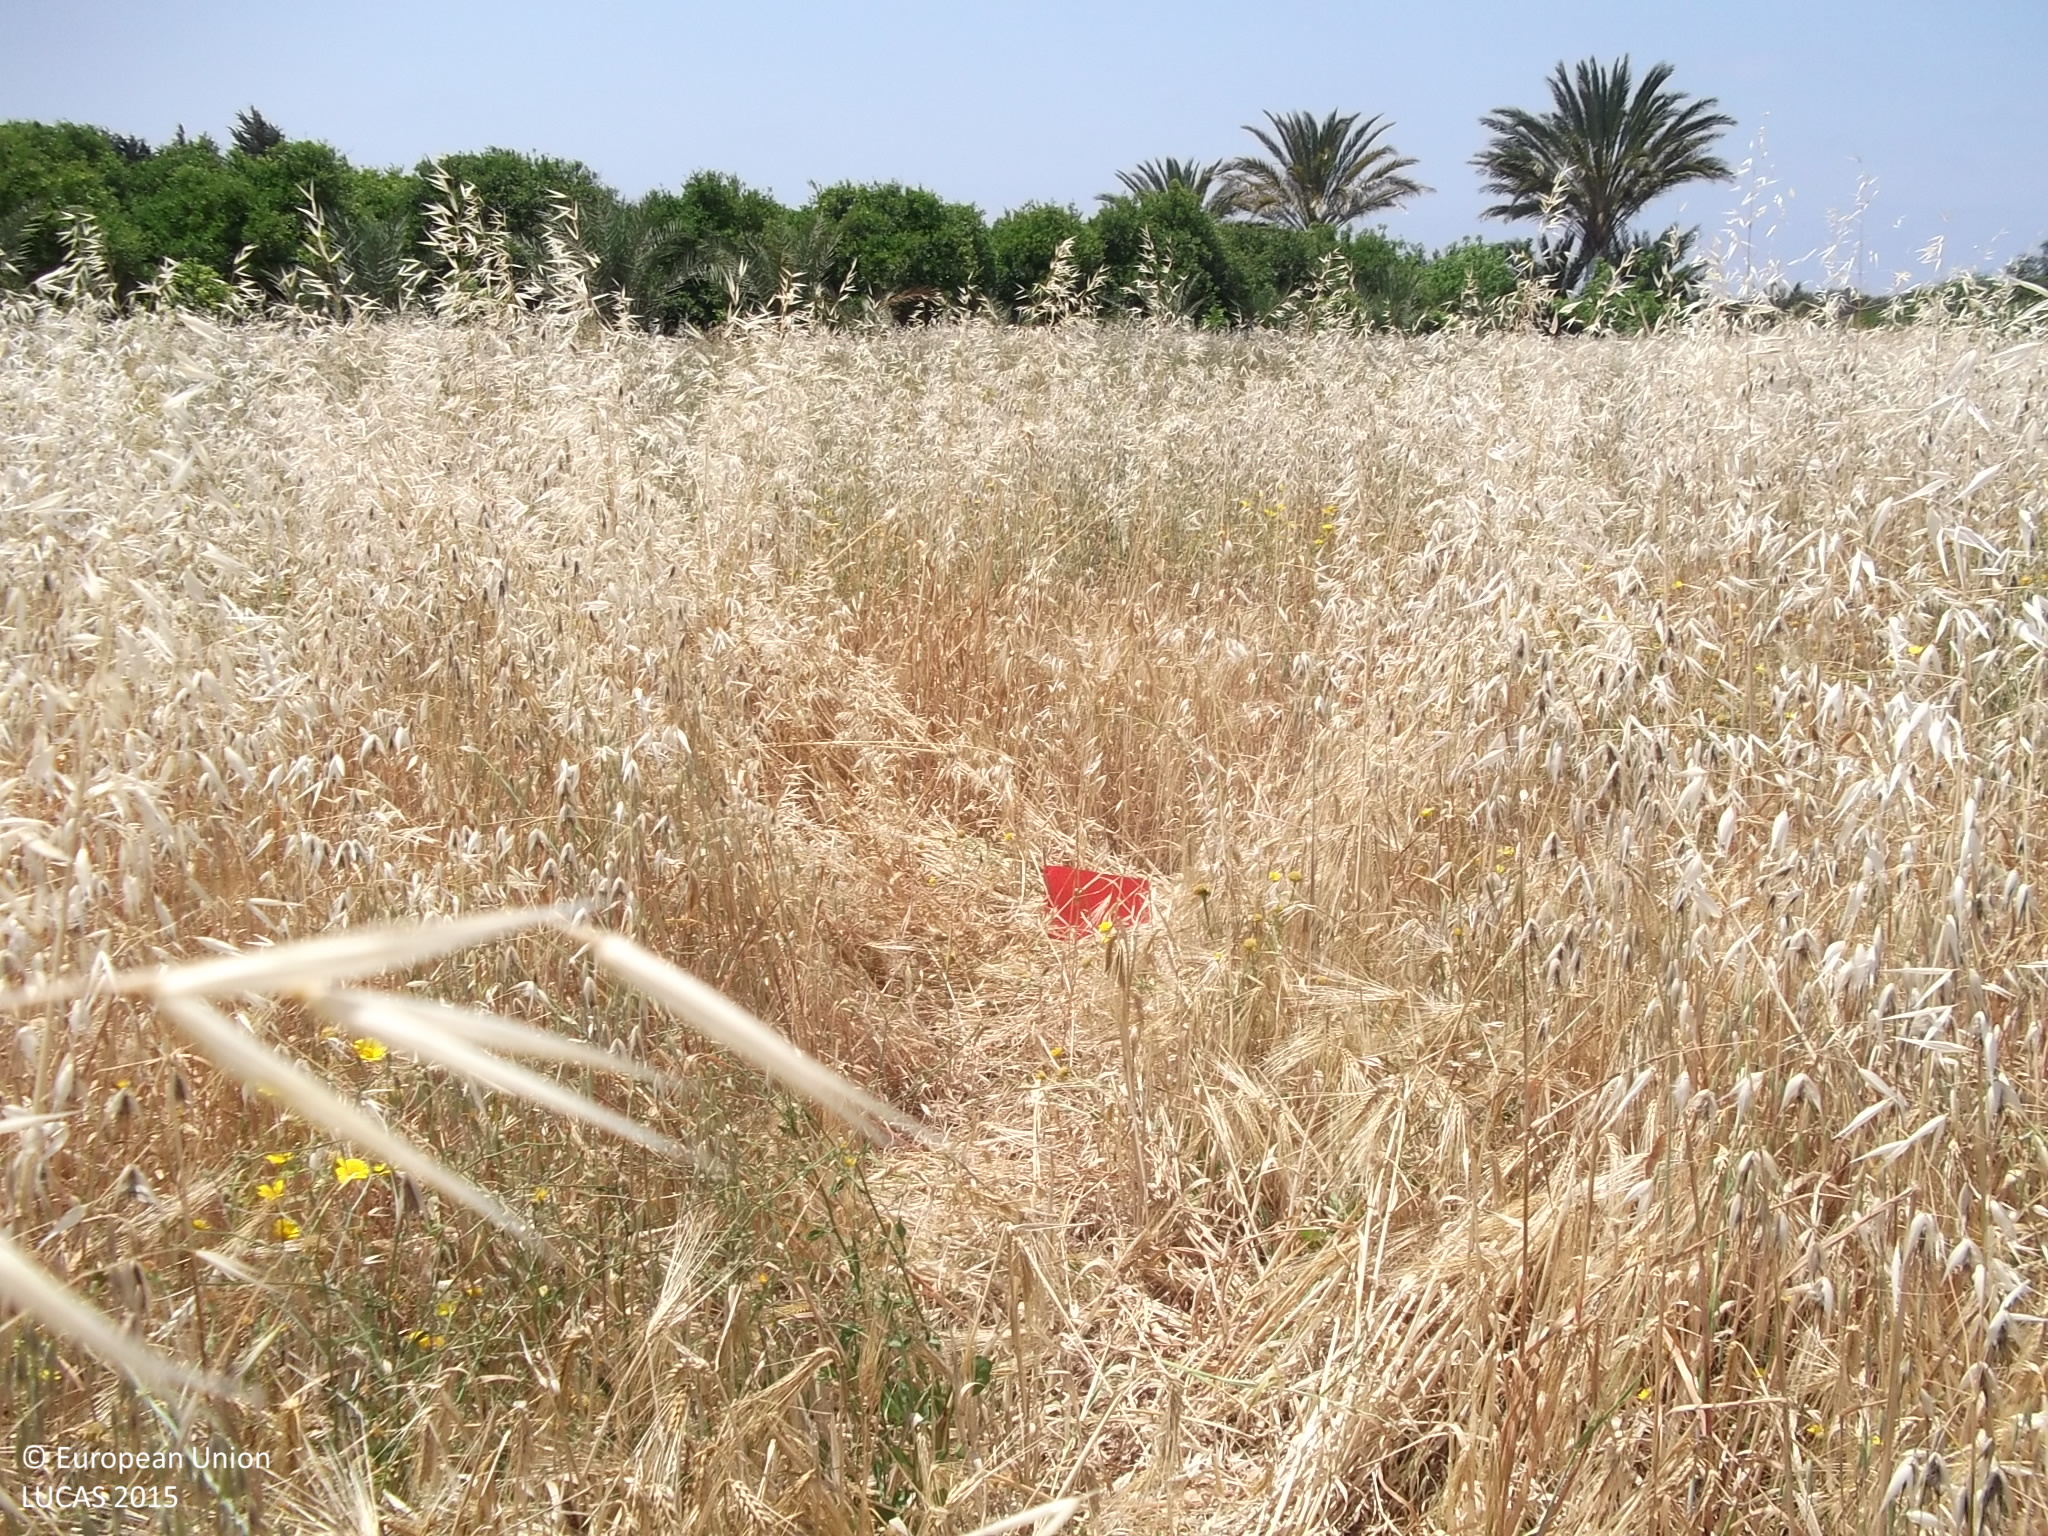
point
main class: Cropland
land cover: Mixed cereals for fodder
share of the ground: > 75 %
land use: Agriculture (excluding fallow land and kitchen gardens)
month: May
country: CY
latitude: 34.6993
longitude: 32.5597
